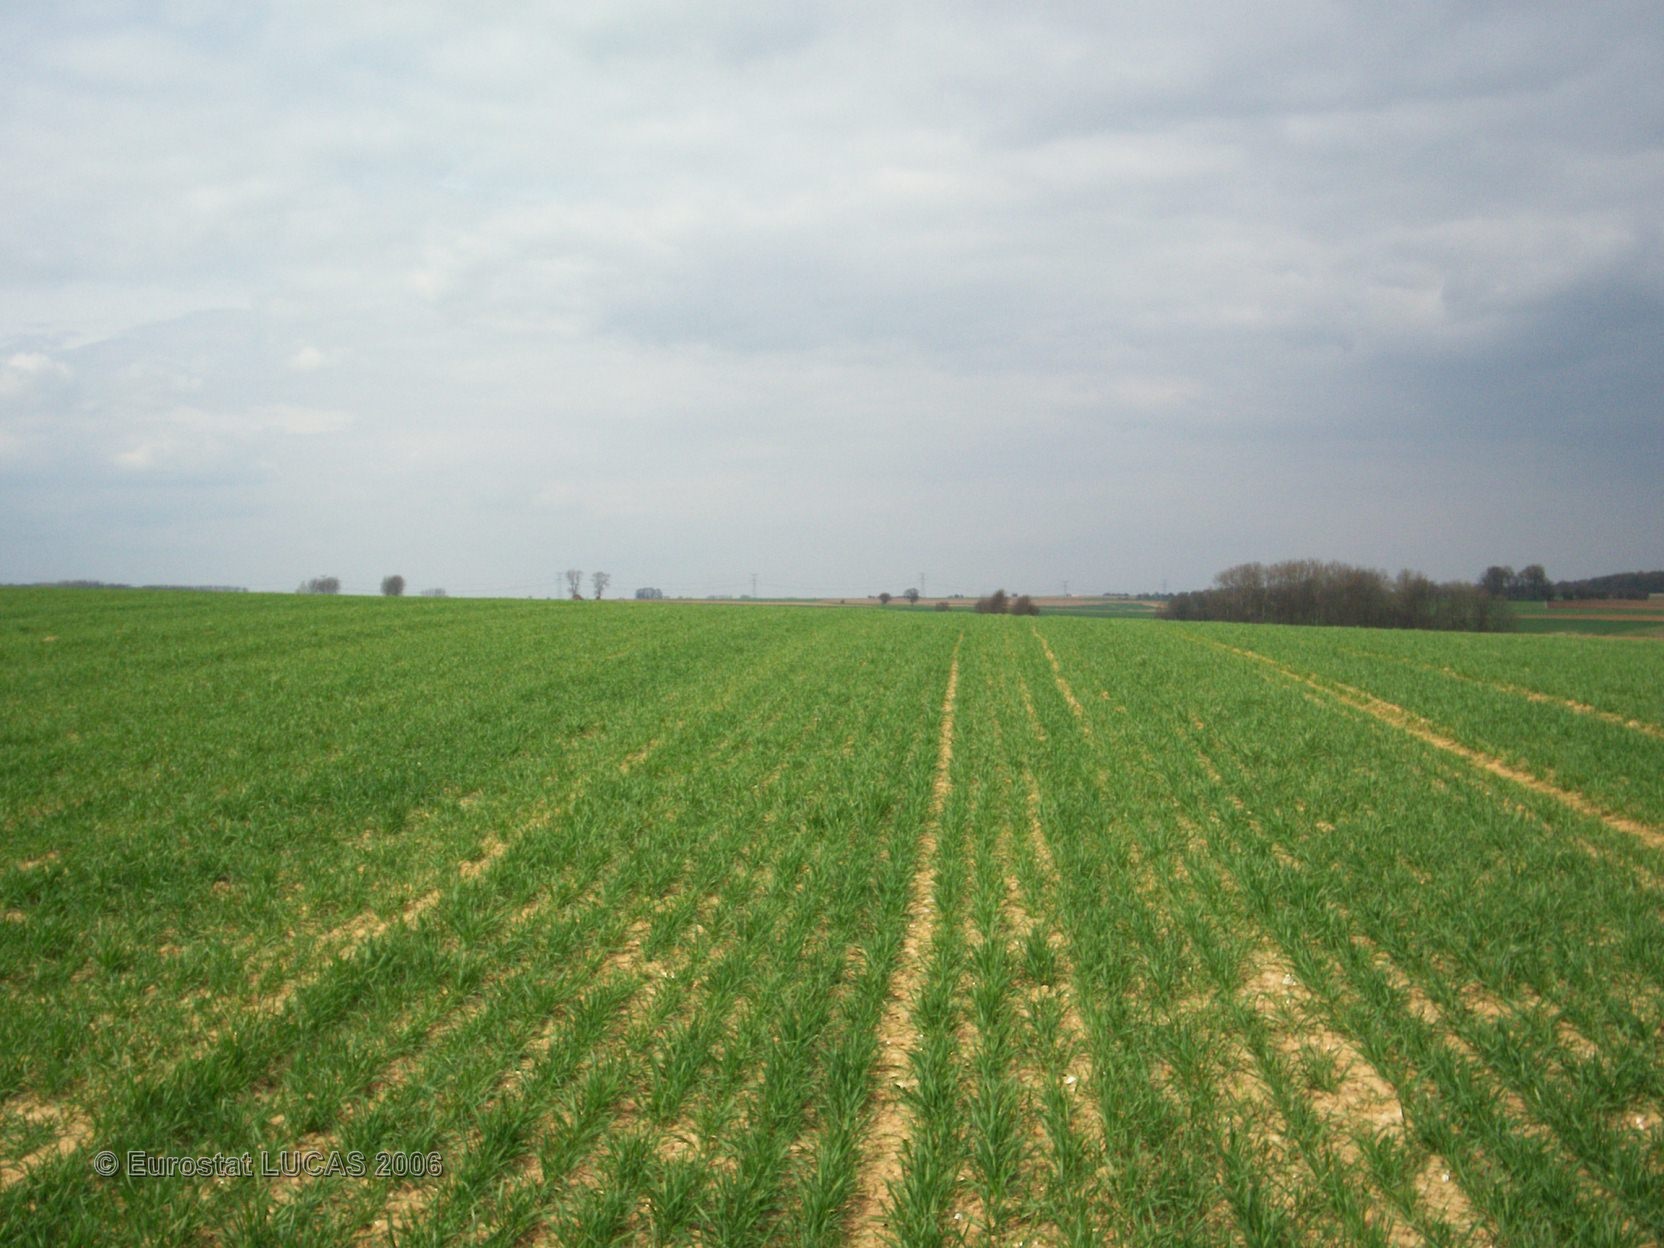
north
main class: Cropland
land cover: Common wheat
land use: Agriculture (excluding fallow land and kitchen gardens)
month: April
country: FR
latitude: 50.0502
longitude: 2.5722
